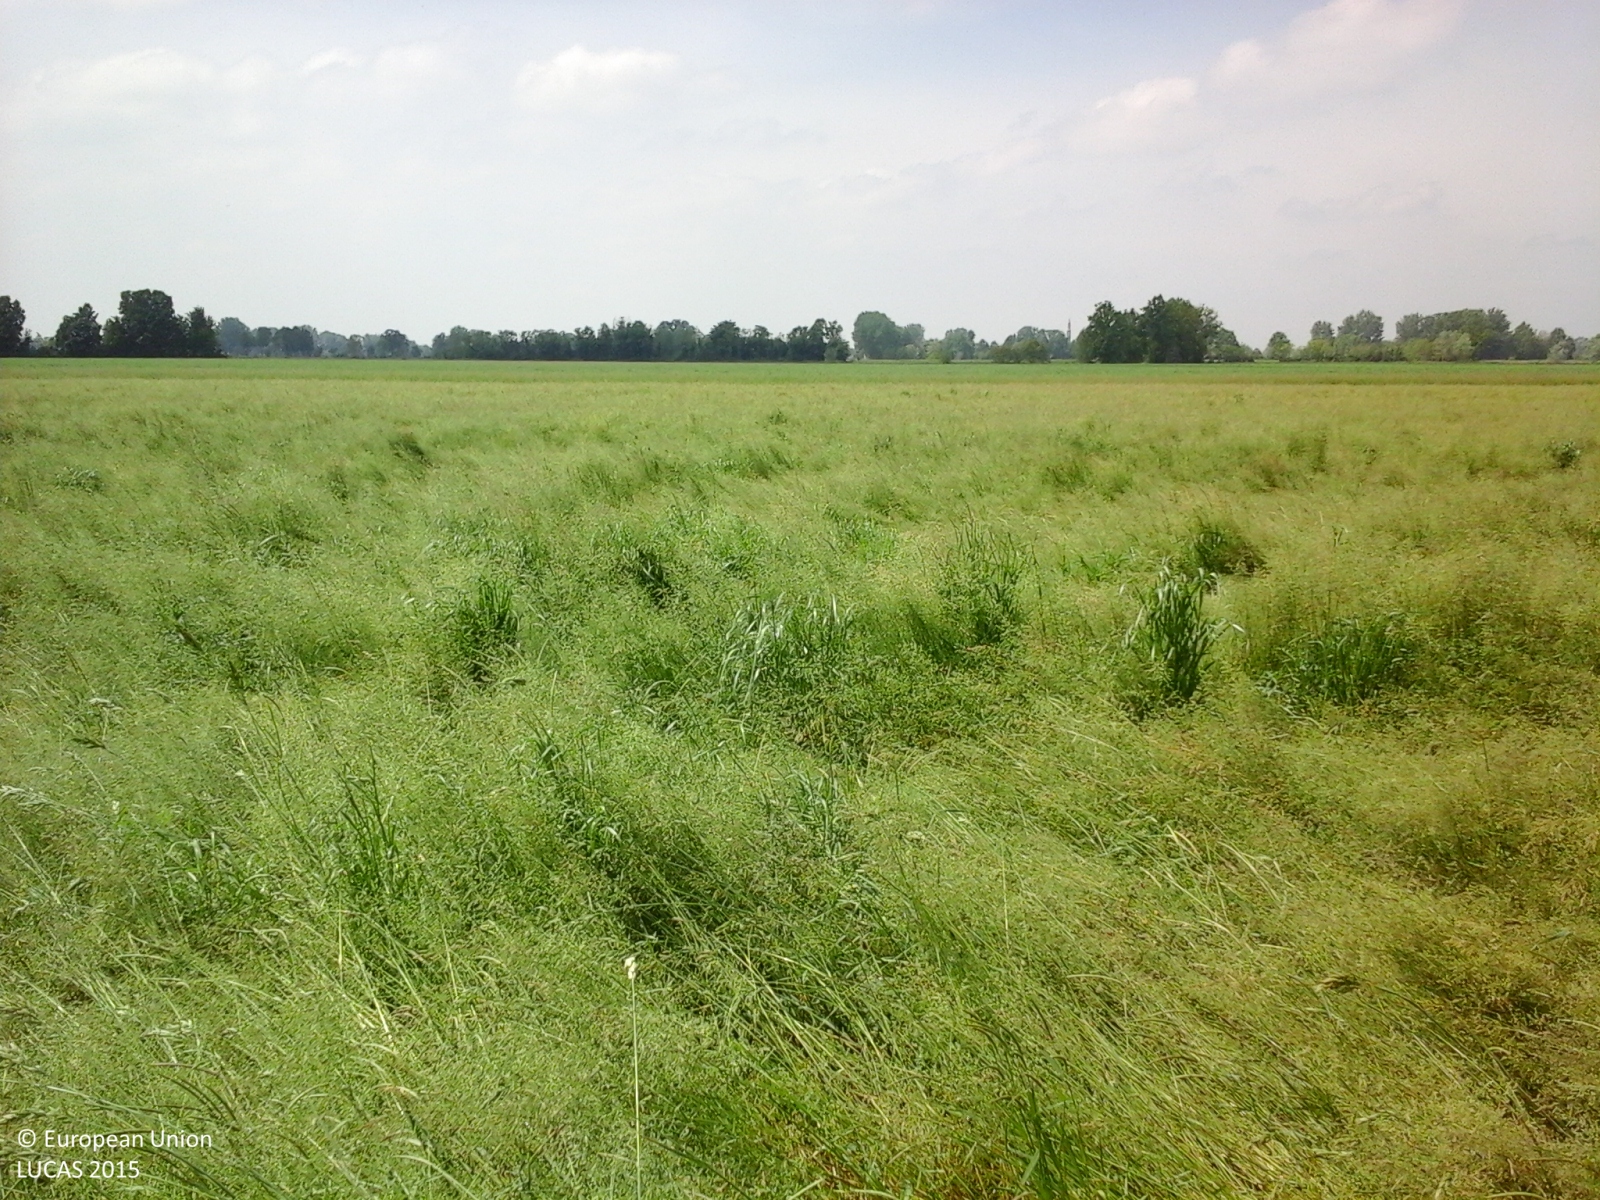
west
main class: Grassland
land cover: Spontaneously vegetated surfaces
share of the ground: > 75 %
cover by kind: herbaceous plants 100 %
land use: Agriculture (excluding fallow land and kitchen gardens)
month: May
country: IT
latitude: 45.1075
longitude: 10.2664
